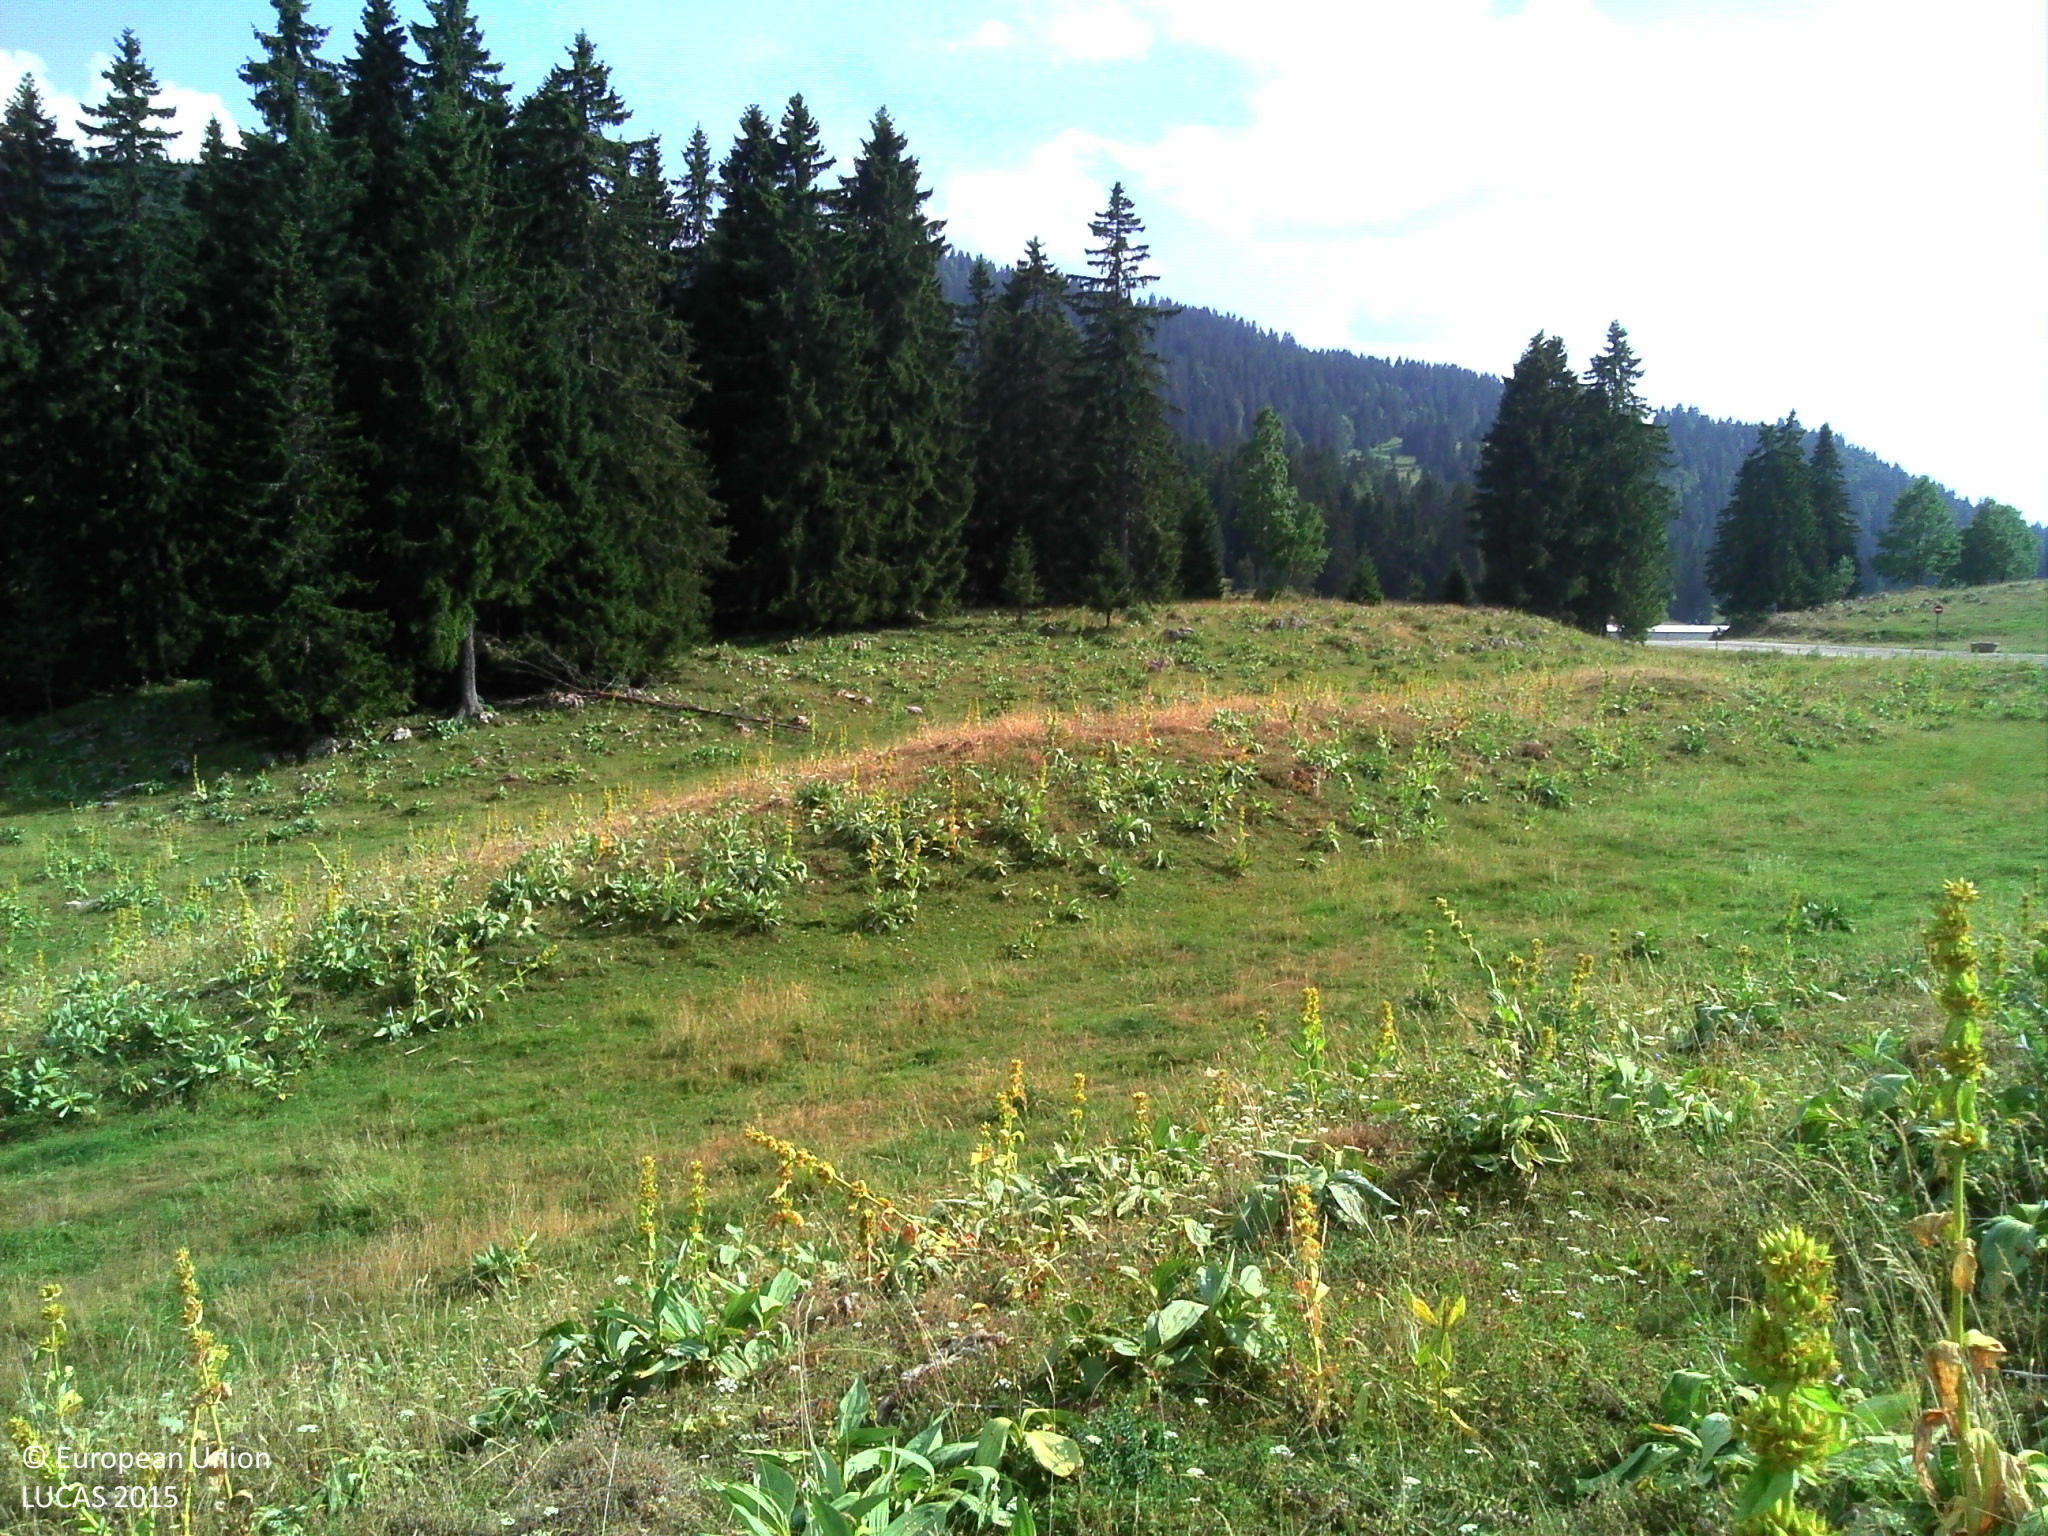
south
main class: Grassland
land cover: Grassland without tree/shrub cover
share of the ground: > 75 %
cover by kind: herbaceous plants 100 %
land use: Agriculture (excluding fallow land and kitchen gardens)
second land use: Sport
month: July
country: FR
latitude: 46.4419
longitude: 6.0851
